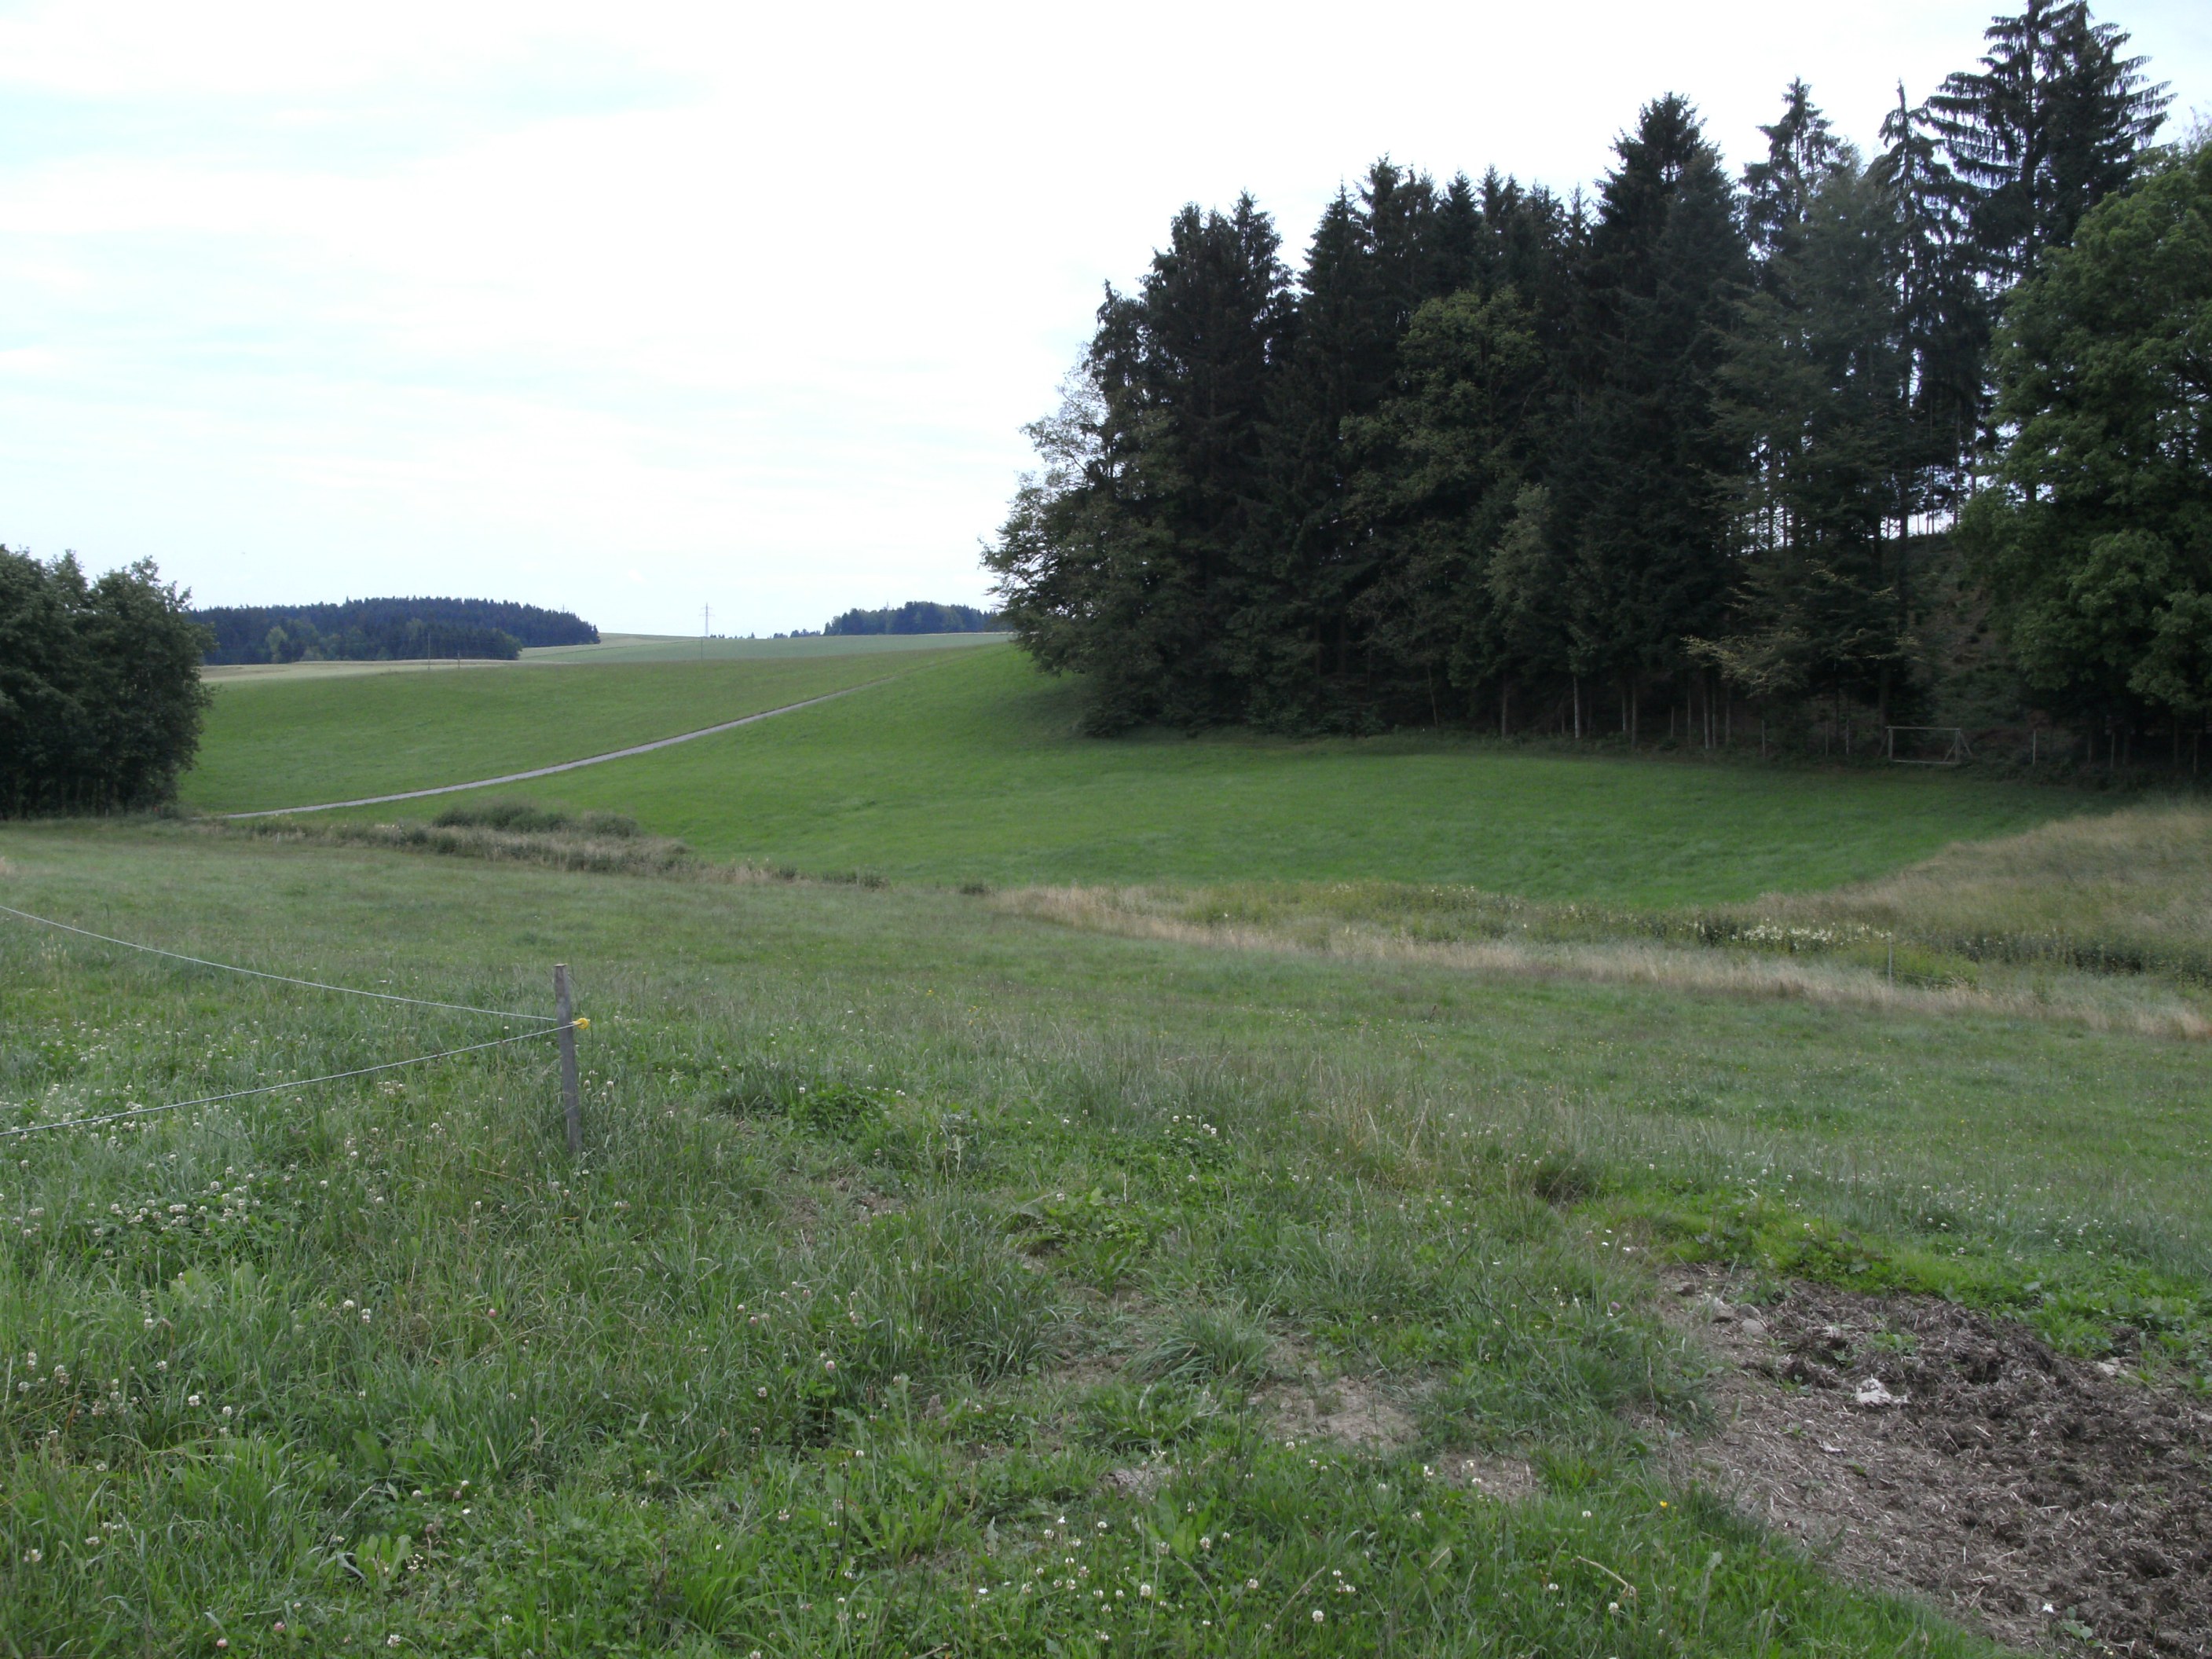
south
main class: Grassland
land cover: Grassland without tree/shrub cover
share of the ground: > 75 %
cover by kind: herbaceous plants 100 %
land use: Agriculture (excluding fallow land and kitchen gardens)
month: June
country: AT
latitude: 48.5200
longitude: 13.7501
